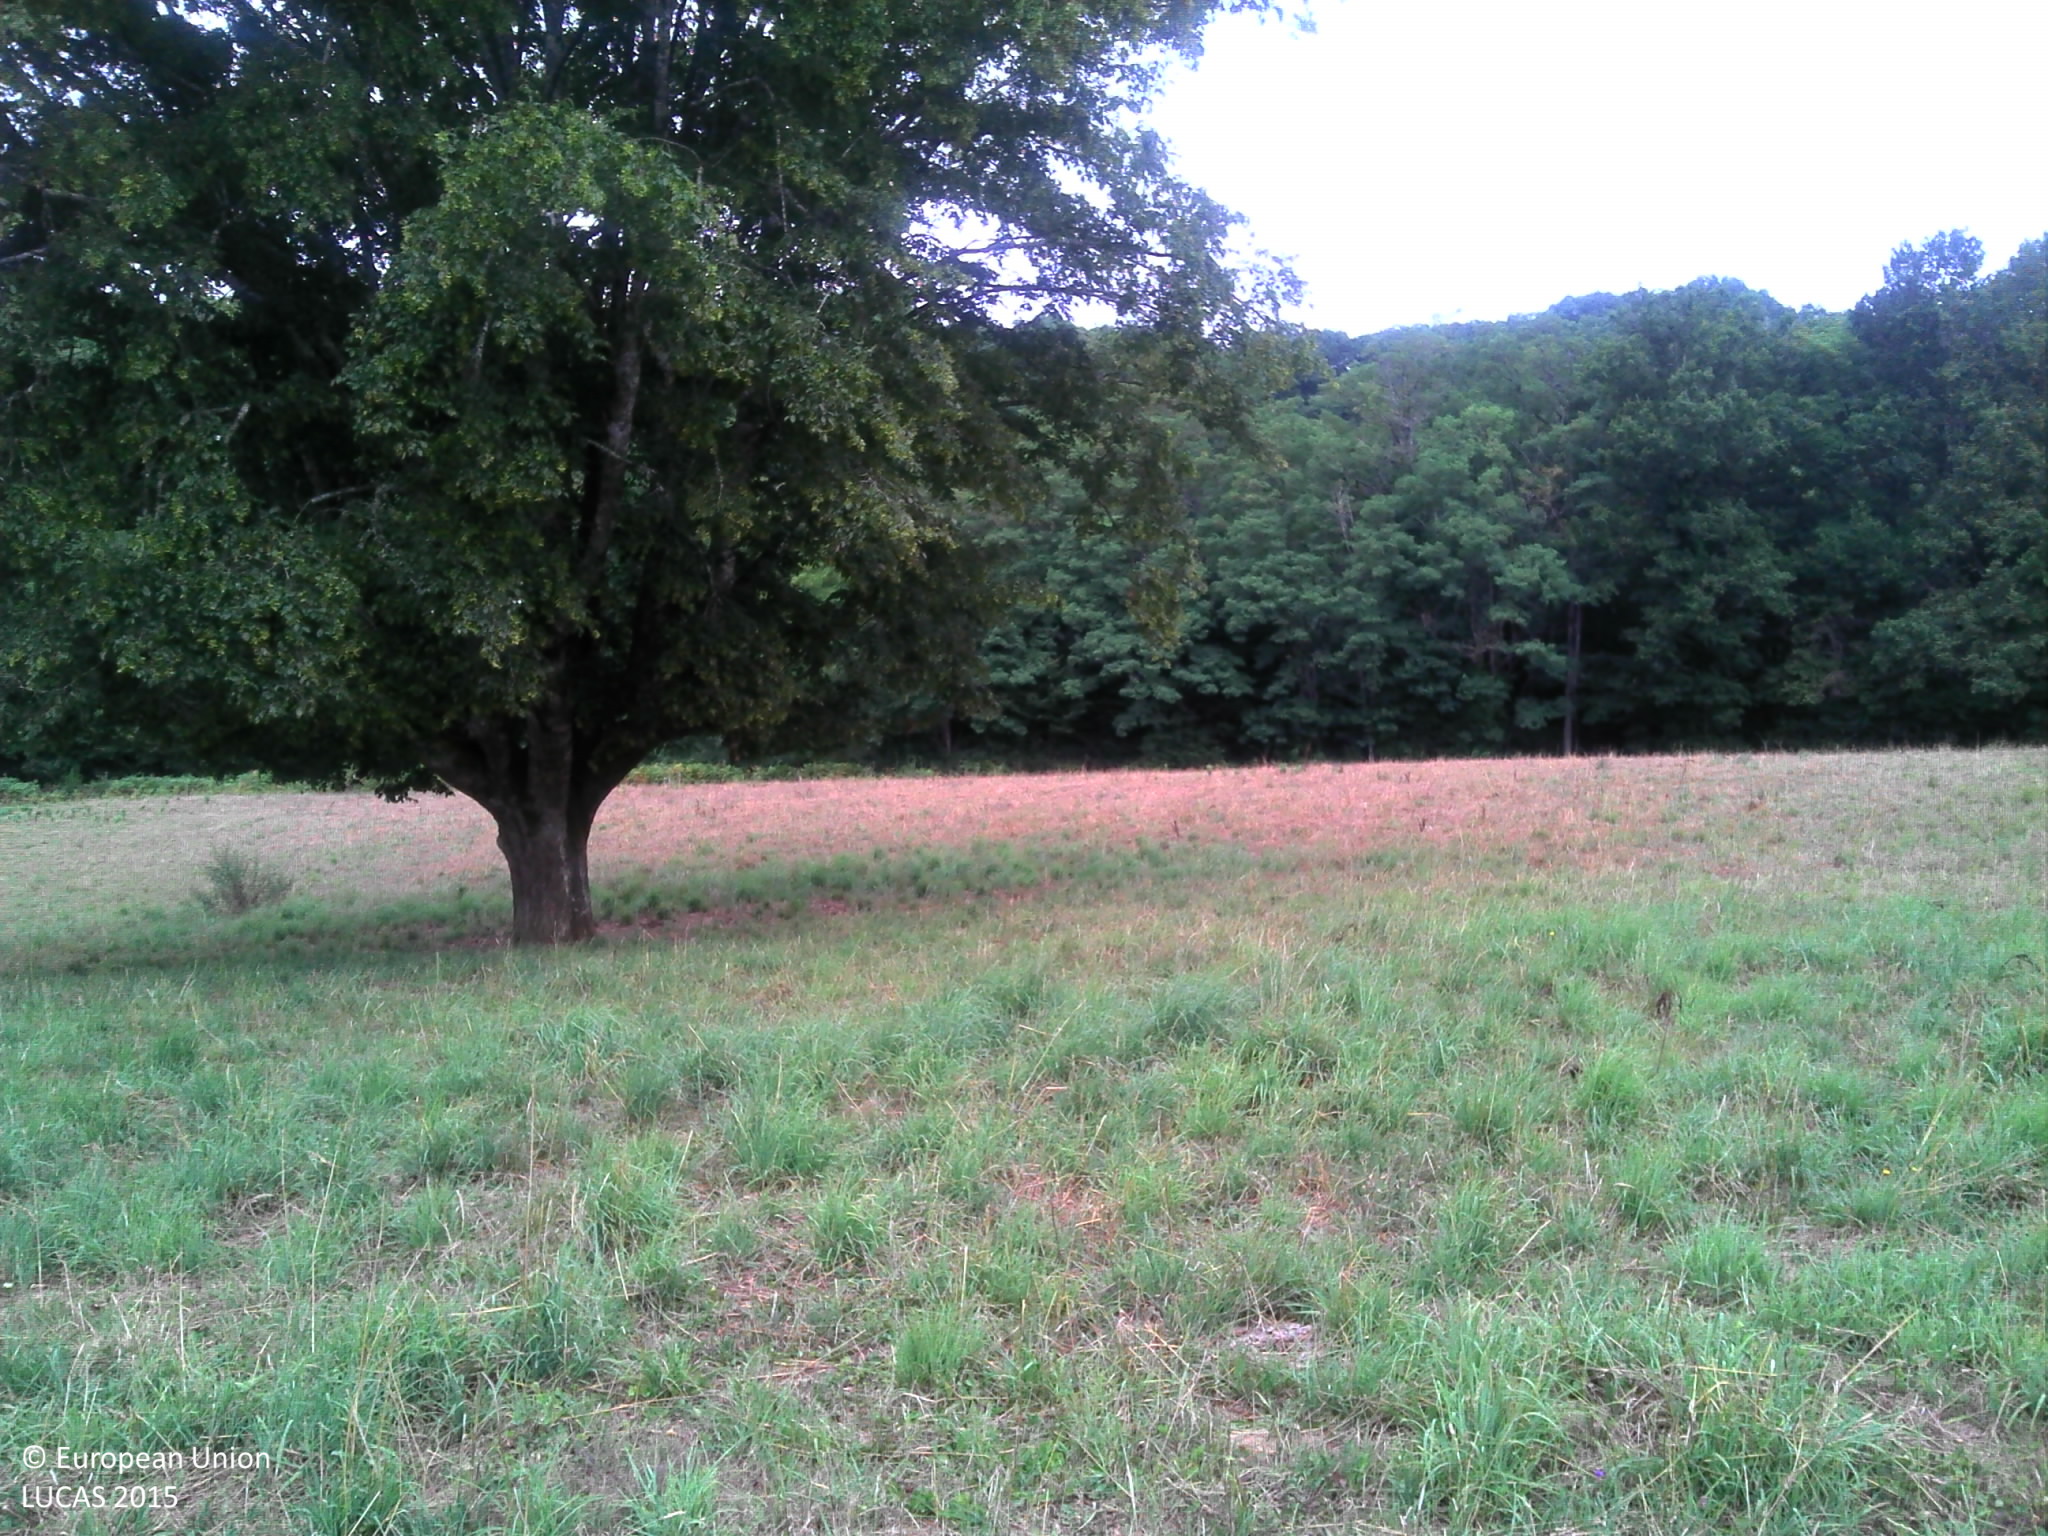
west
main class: Grassland
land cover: Grassland without tree/shrub cover
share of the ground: > 75 %
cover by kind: herbaceous plants 95 %, shrubs 5 %
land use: Agriculture (excluding fallow land and kitchen gardens)
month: July
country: FR
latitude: 45.3608
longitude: 1.5047
